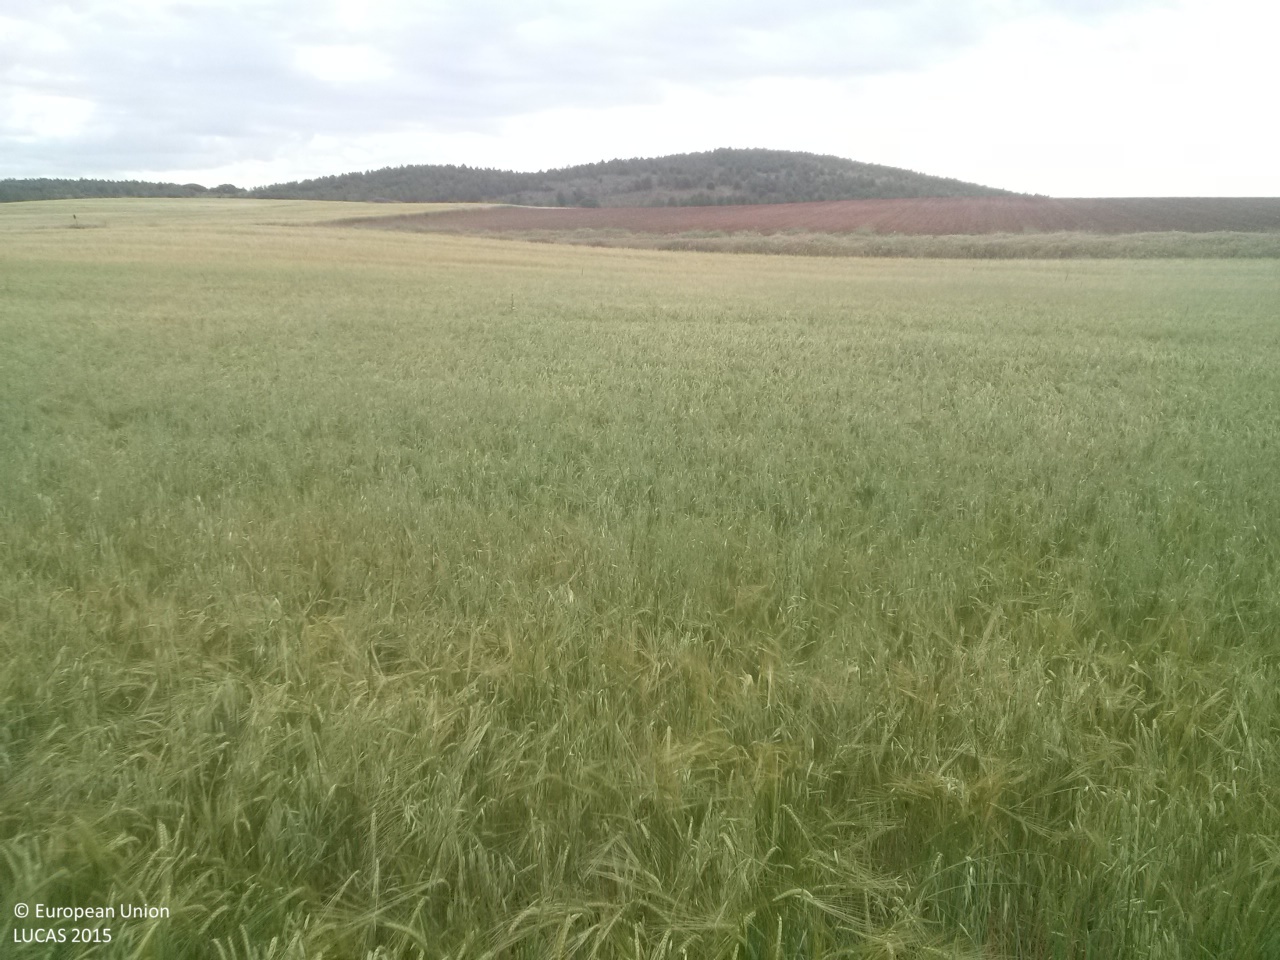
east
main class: Cropland
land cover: Barley
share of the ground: > 75 %
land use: Agriculture (excluding fallow land and kitchen gardens)
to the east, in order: Barley; Grass margins; Tracks; Grass margins; Barley
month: May
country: ES
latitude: 40.0692
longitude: -2.9094
